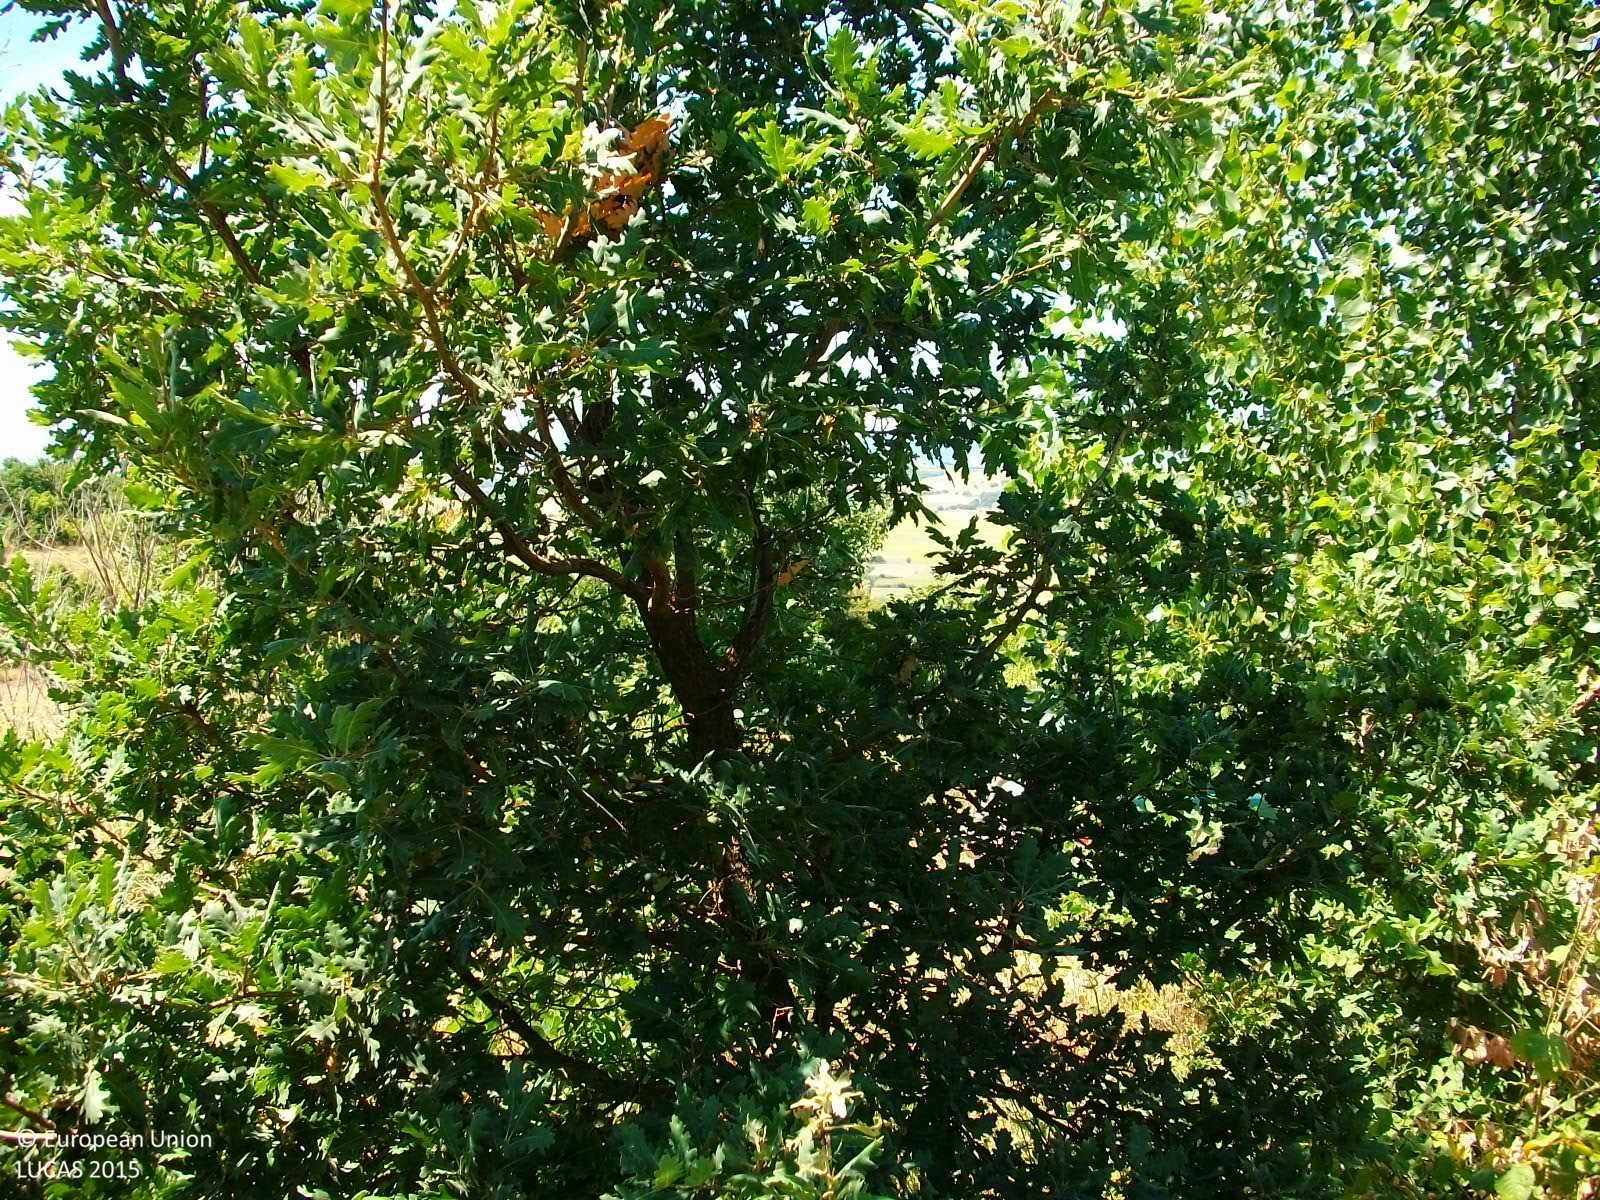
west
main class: Grassland
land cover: Grassland with sparse tree/shrub cover
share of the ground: > 75 %
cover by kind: herbaceous plants 85 %, shrubs 10 %, broadleaved forest trees 5 %
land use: Amenities, museums, leisure
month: July
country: GR
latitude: 41.5174
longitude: 26.2377
